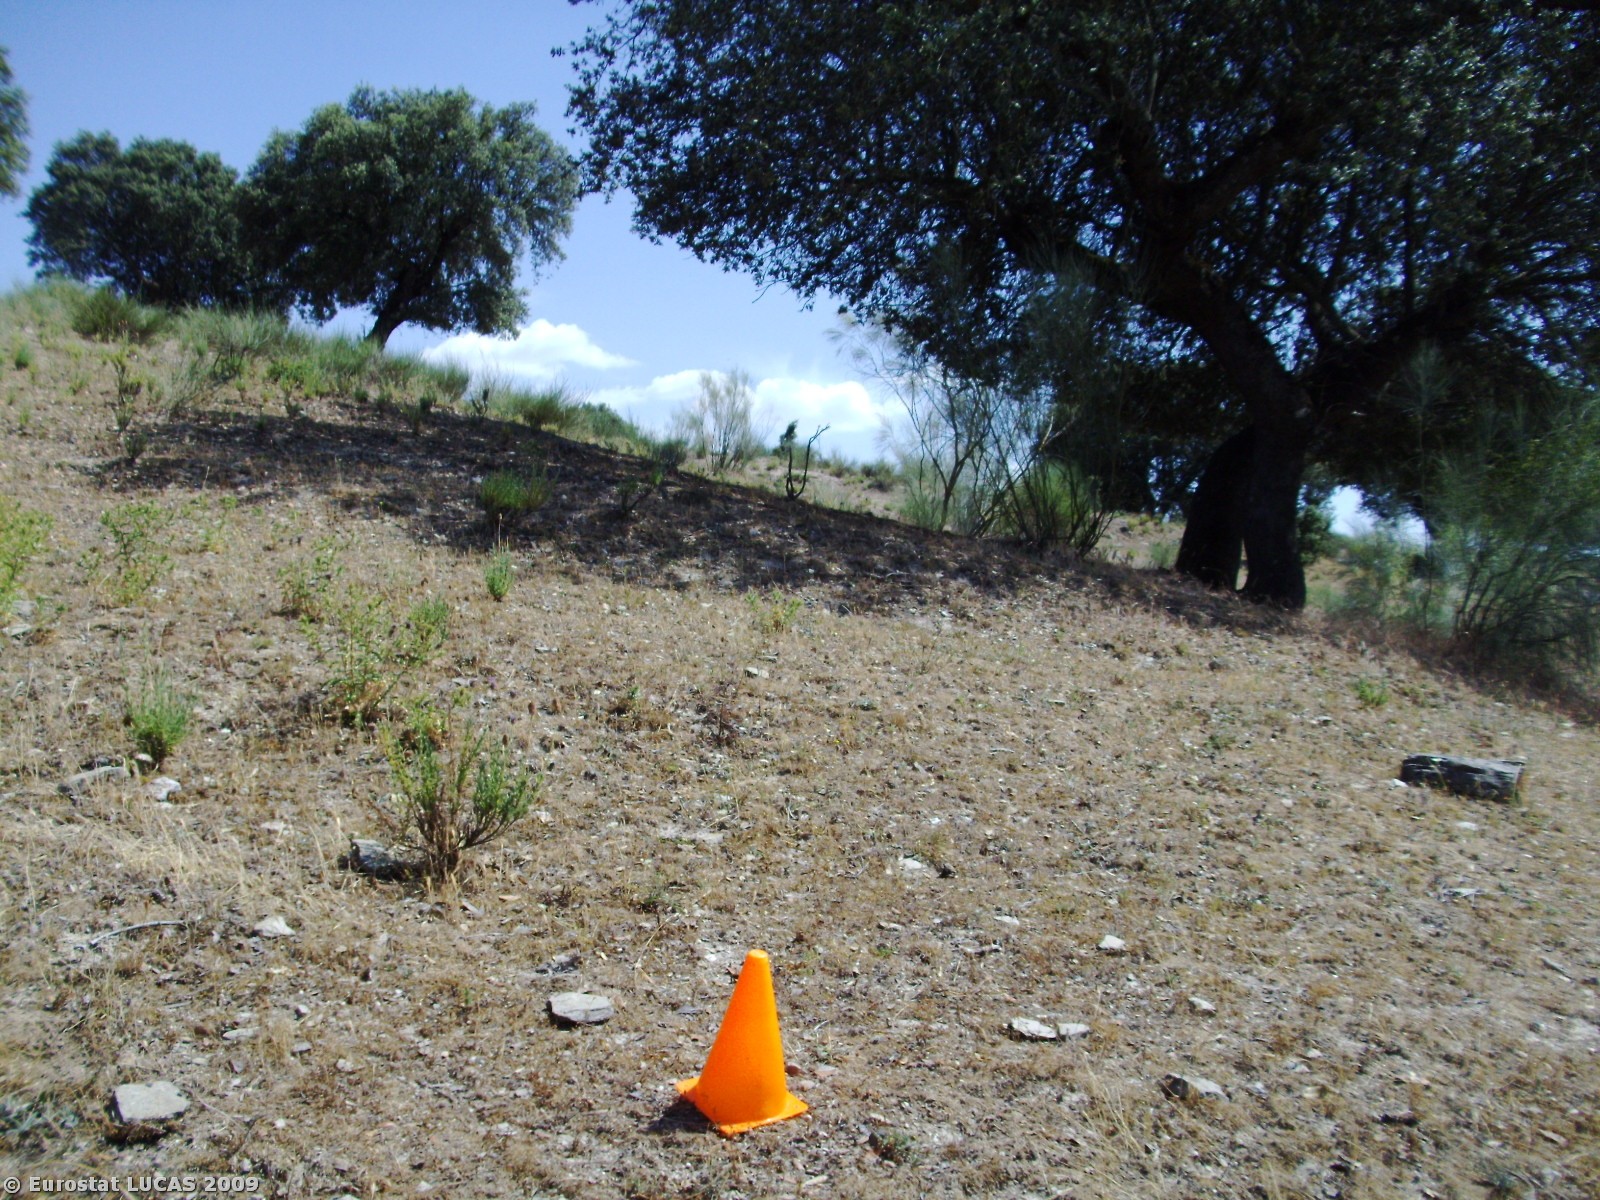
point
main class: Woodland
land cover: Broadleaved woodland
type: broadleaved evergreen forest
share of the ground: 50 - 75 %
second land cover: Spontaneously vegetated surfaces
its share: < 10 %
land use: Forestry
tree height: > 5 m
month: June
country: PT
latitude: 39.7548
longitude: -7.0701
